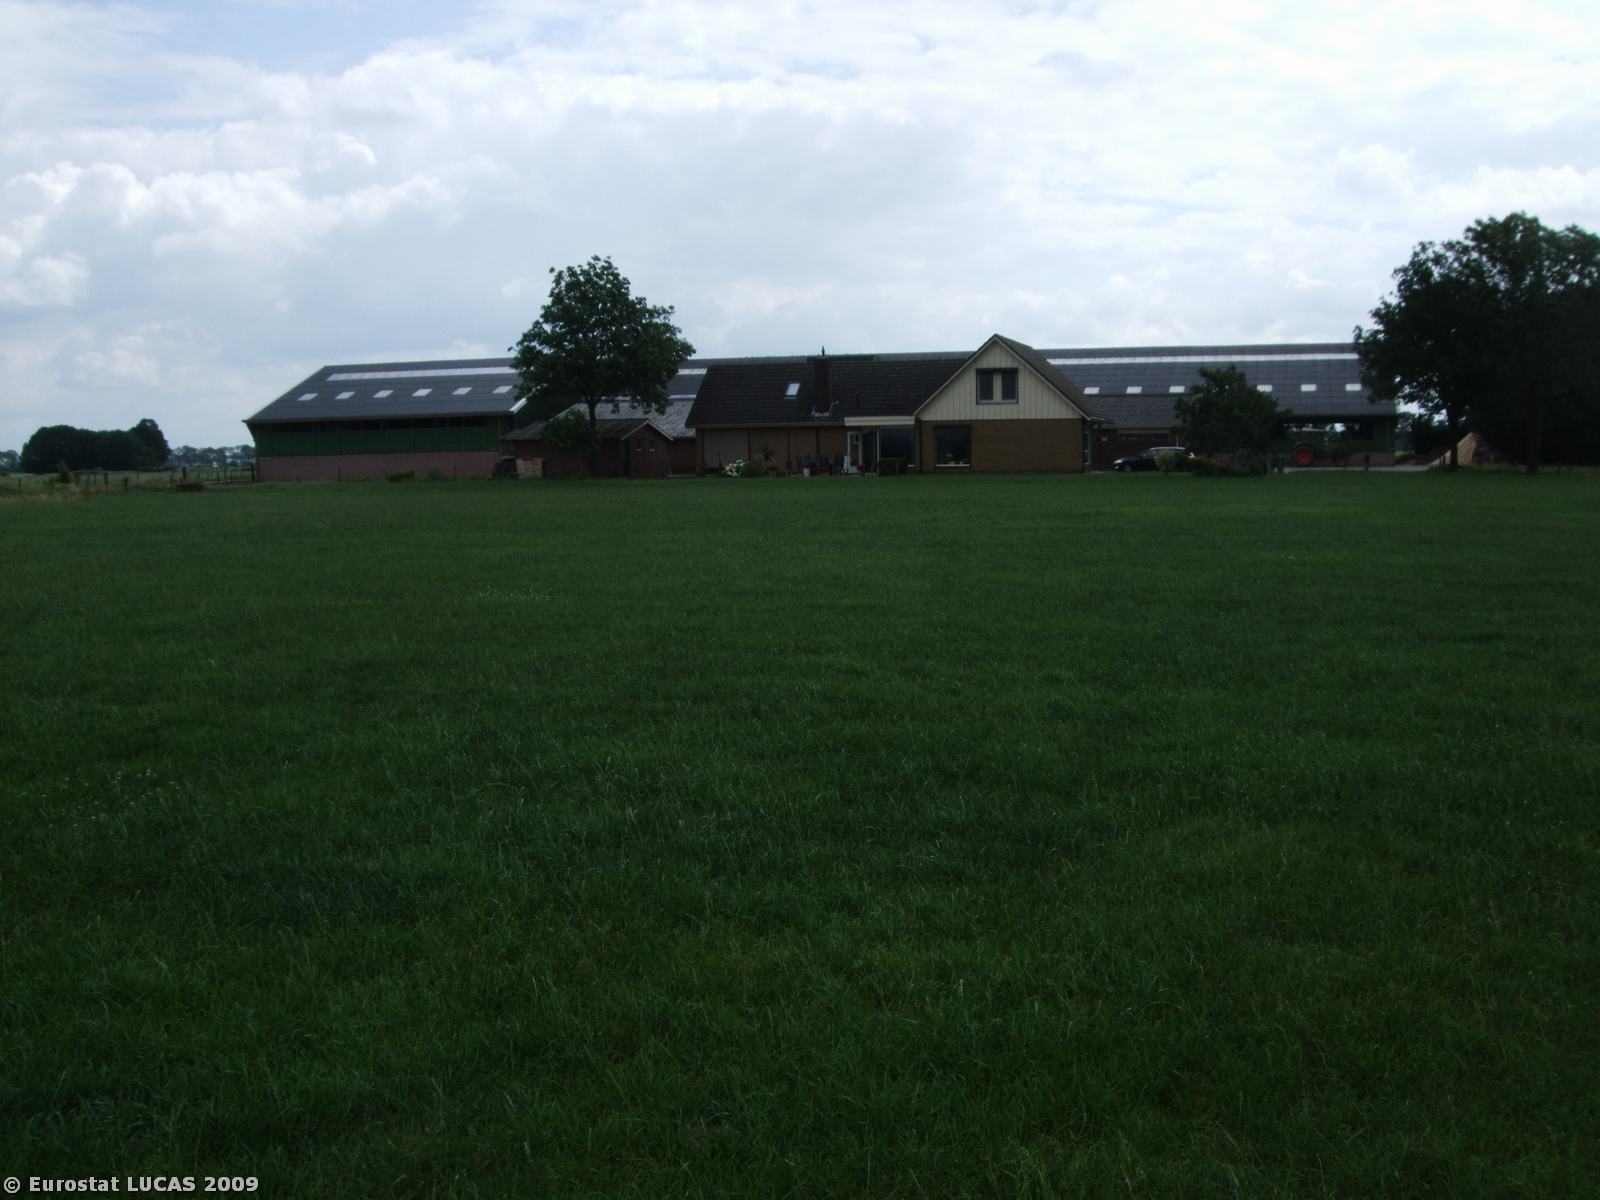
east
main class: Grassland
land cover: Grassland without tree/shrub cover
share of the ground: > 75 %
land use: Agriculture (excluding fallow land and kitchen gardens)
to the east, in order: Grassland without tree/shrub cover; Artificial constructions in urban areas; Grassland without tree/shrub cover; Tracks
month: July
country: NL
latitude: 51.9719
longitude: 6.1126
